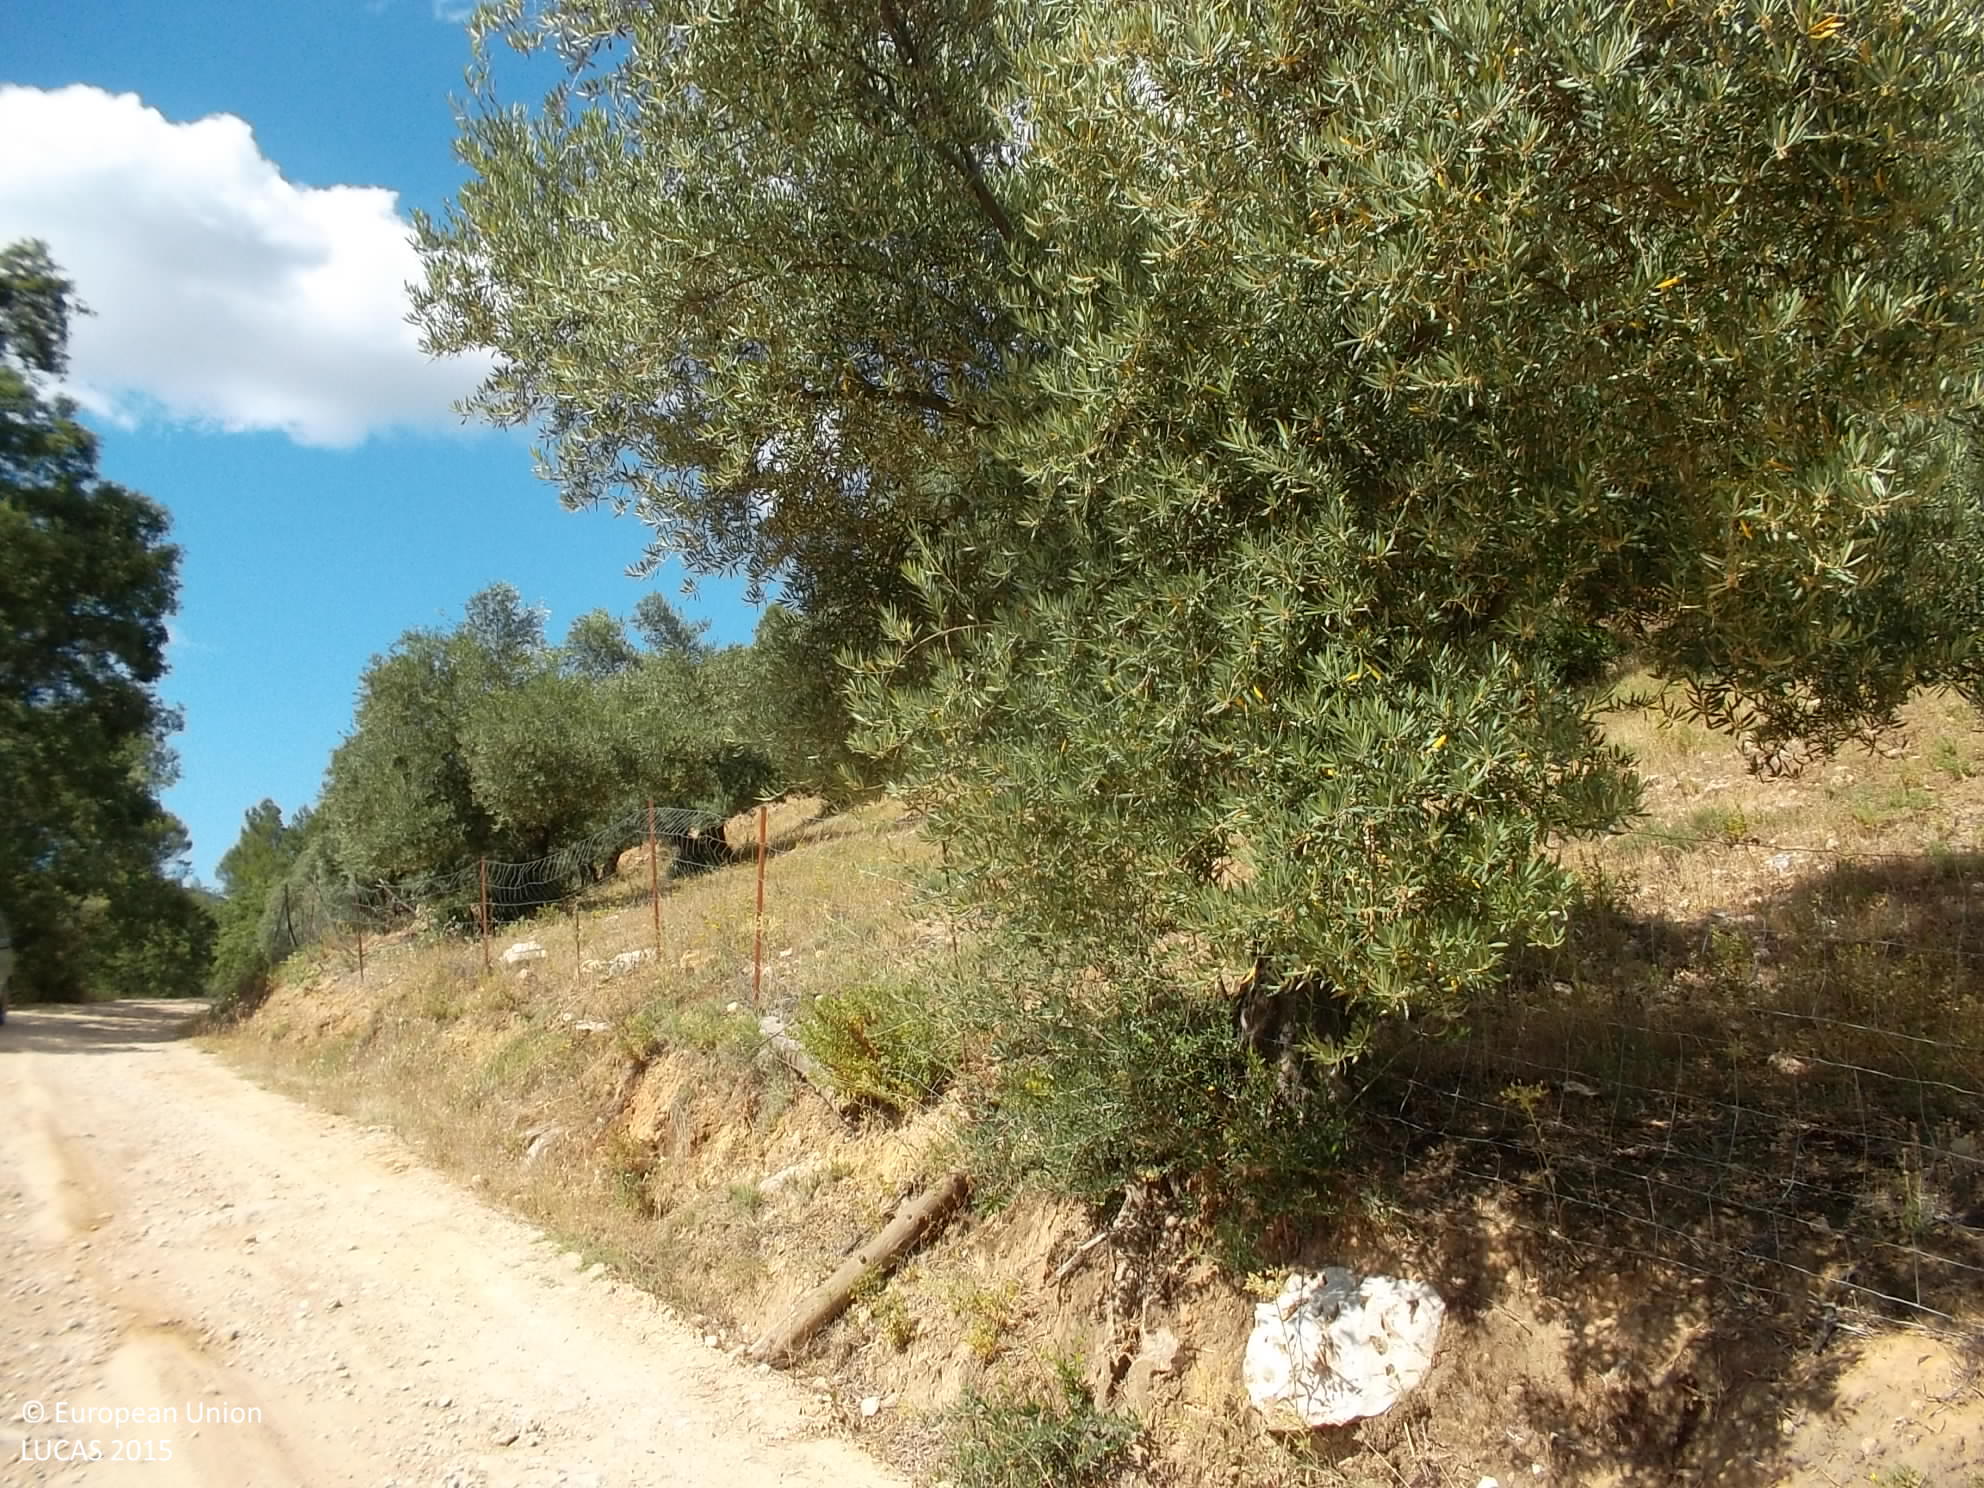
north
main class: Woodland
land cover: Pine dominated mixed woodland
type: alpine coniferous forest
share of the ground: 25 - 50 %
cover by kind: coniferous forest trees 40 %, shrubs 30 %, broadleaved forest trees 20 %, consolidated bare surface 10 %
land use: Forestry
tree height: > 5 m
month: June
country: ES
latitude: 38.0106
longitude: -2.9690
